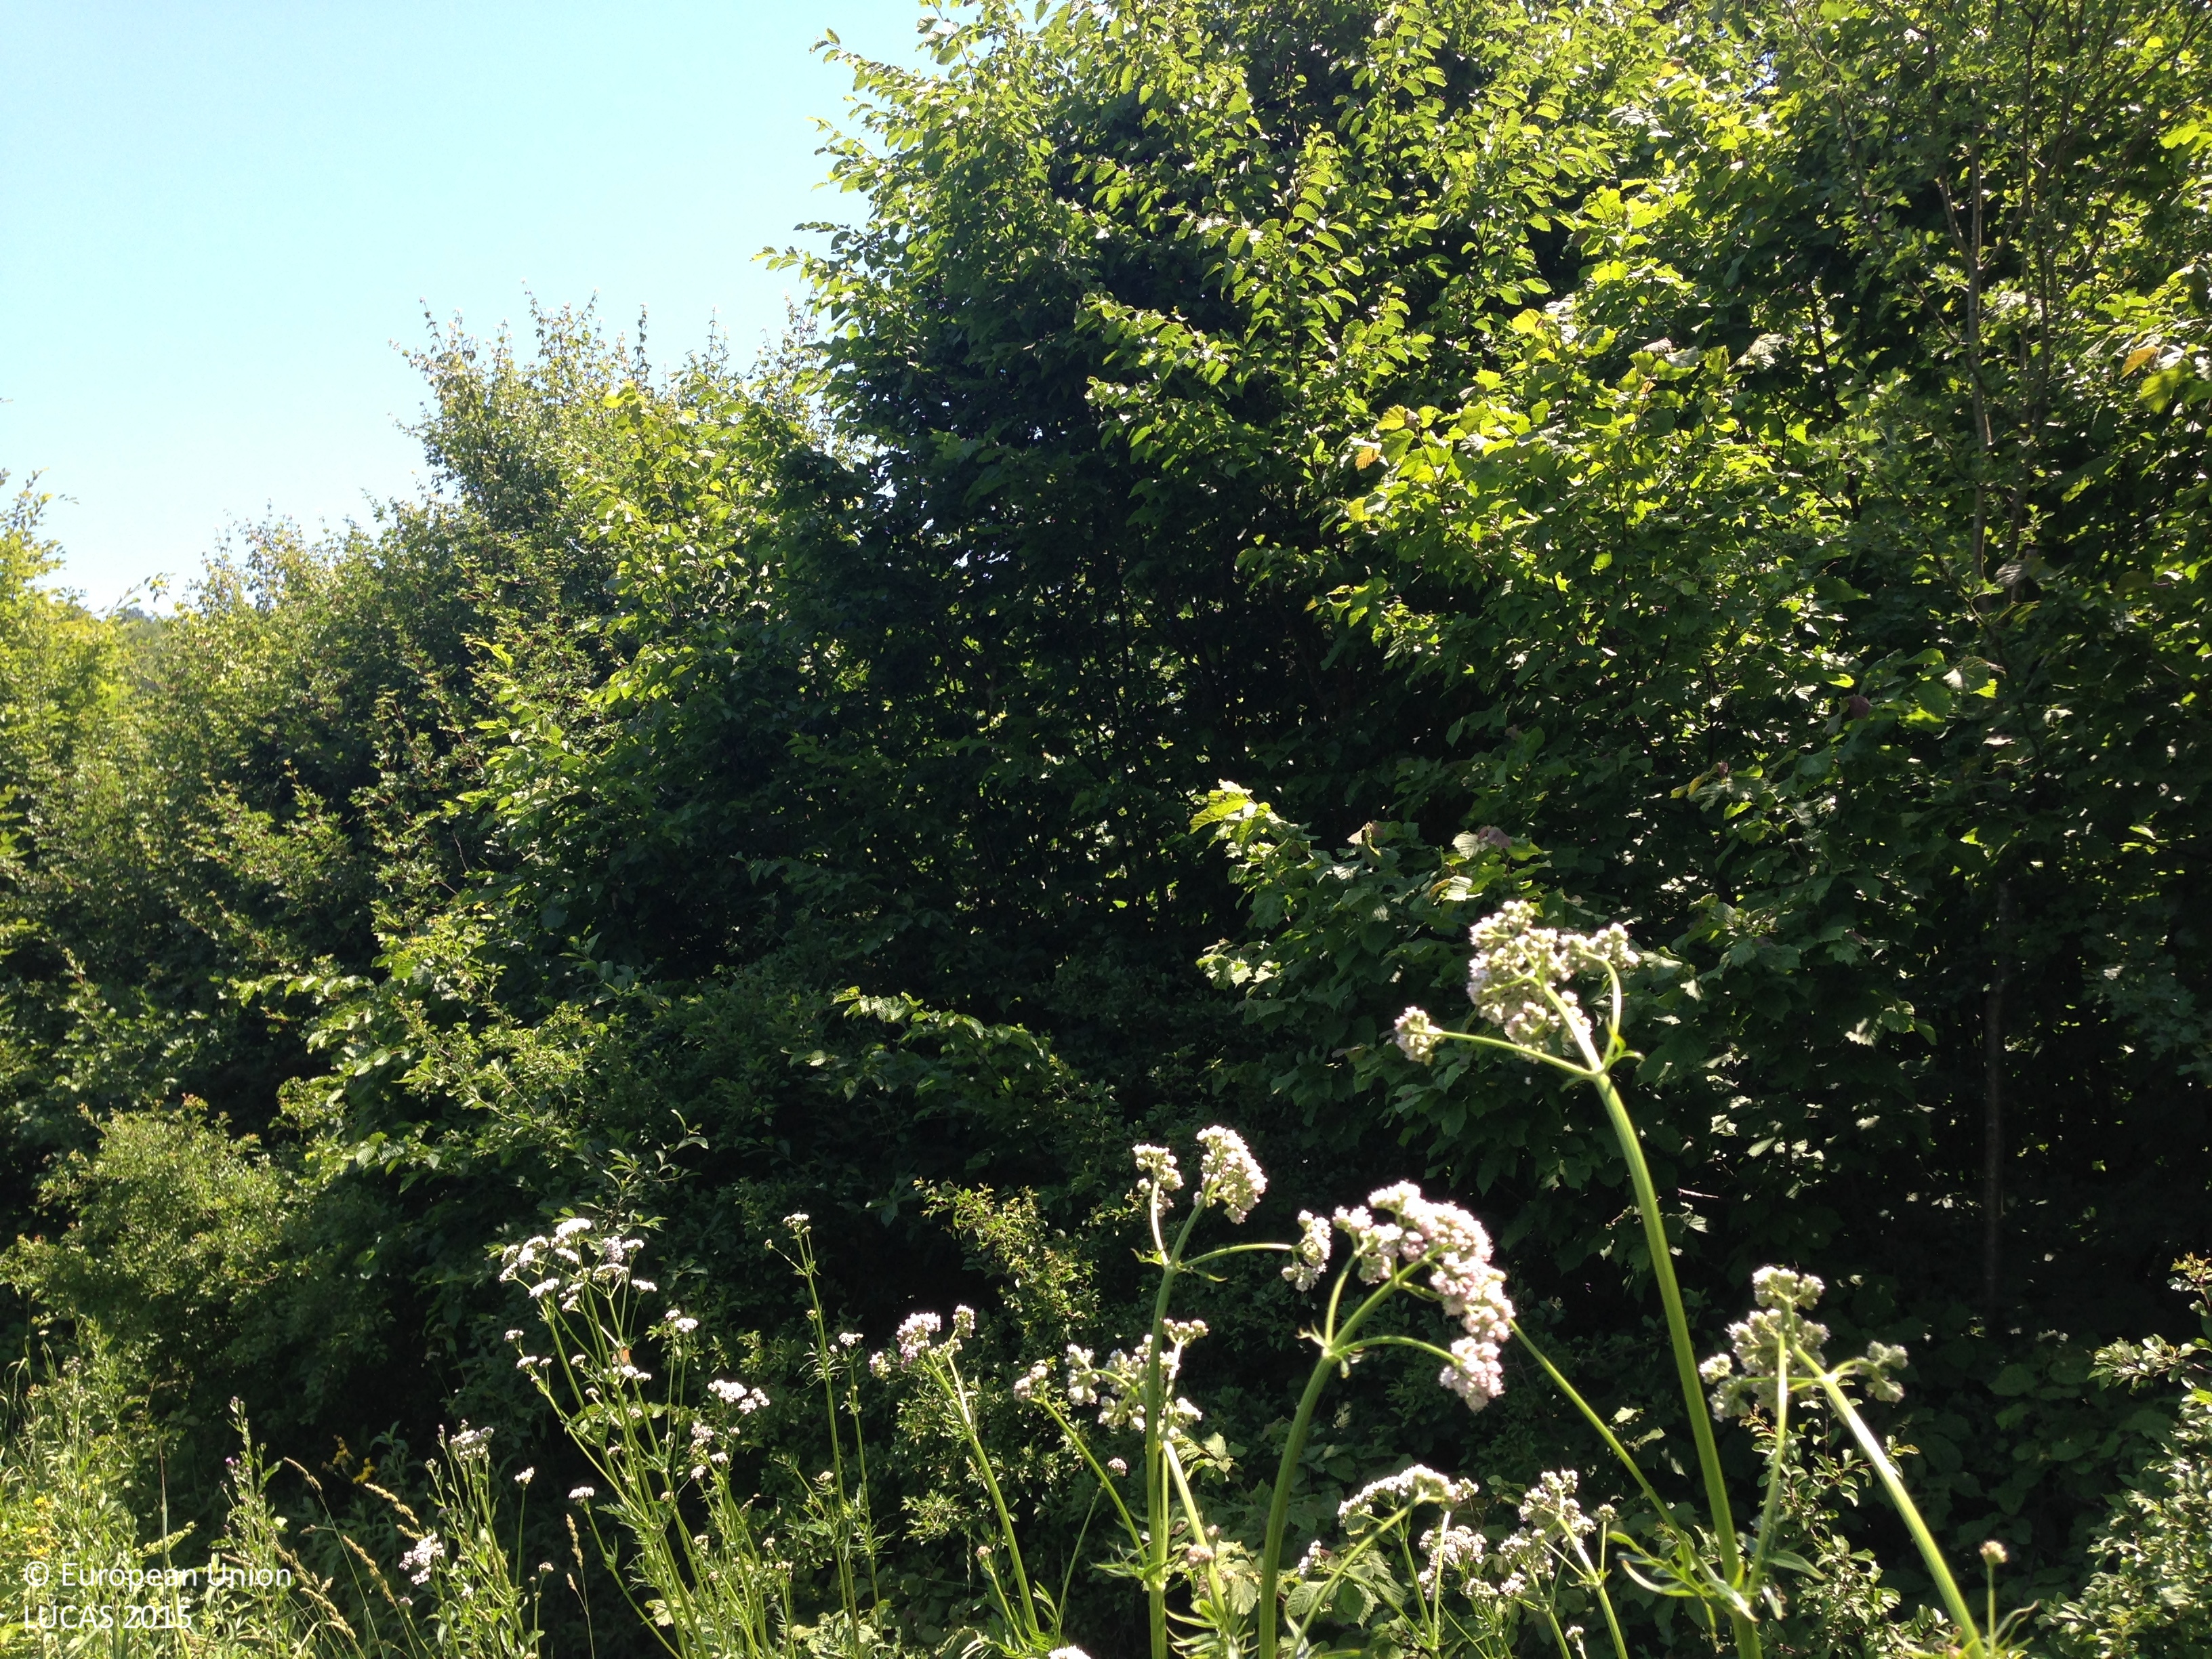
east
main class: Woodland
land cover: Broadleaved woodland
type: thermophilous deciduous forest
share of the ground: 25 - 50 %
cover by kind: herbaceous plants 40 %, broadleaved forest trees 30 %, shrubs 30 %
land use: Forestry
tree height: > 5 m
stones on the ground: < 10 %
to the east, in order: Broadleaved woodland; Tracks; Broadleaved woodland; Ditches and canals; Broadleaved woodland; Electric lines; Broadleaved woodland; Ditches and canals; Broadleaved woodland; Ditches and canals; Broadleaved woodland
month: July
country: HR
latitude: 44.5986
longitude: 15.2217
